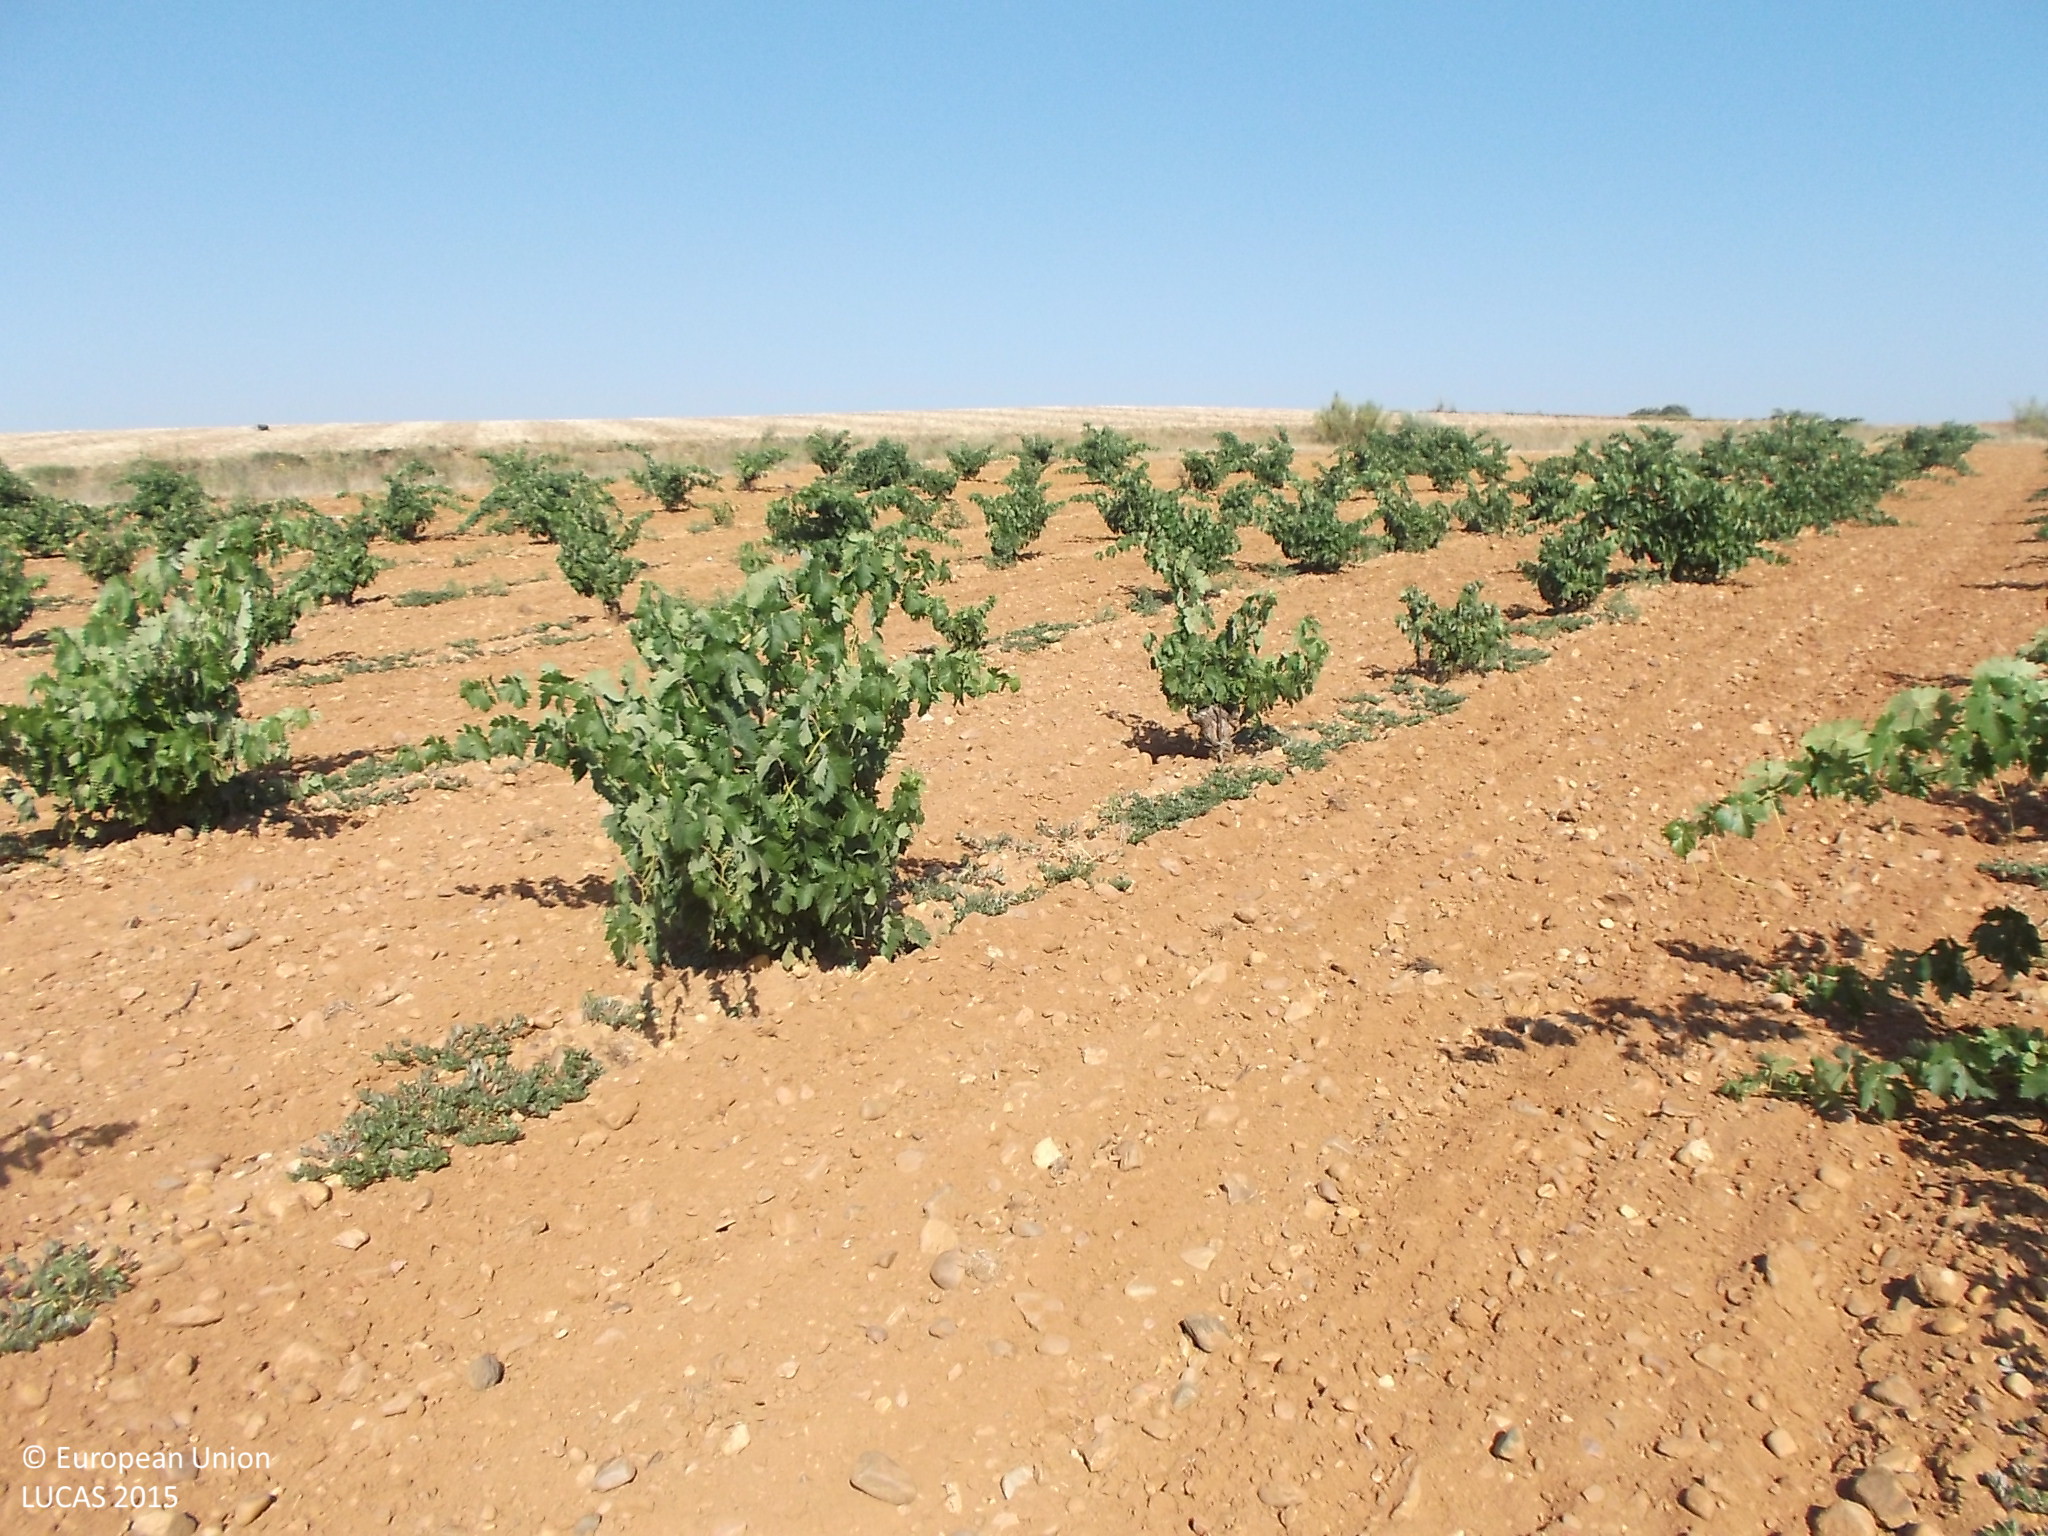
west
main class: Cropland
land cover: Vineyards
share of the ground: 10 - 25 %
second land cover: Other bare soil
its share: > 75 %
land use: Agriculture (excluding fallow land and kitchen gardens)
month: July
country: ES
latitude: 41.4338
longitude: -5.3845
